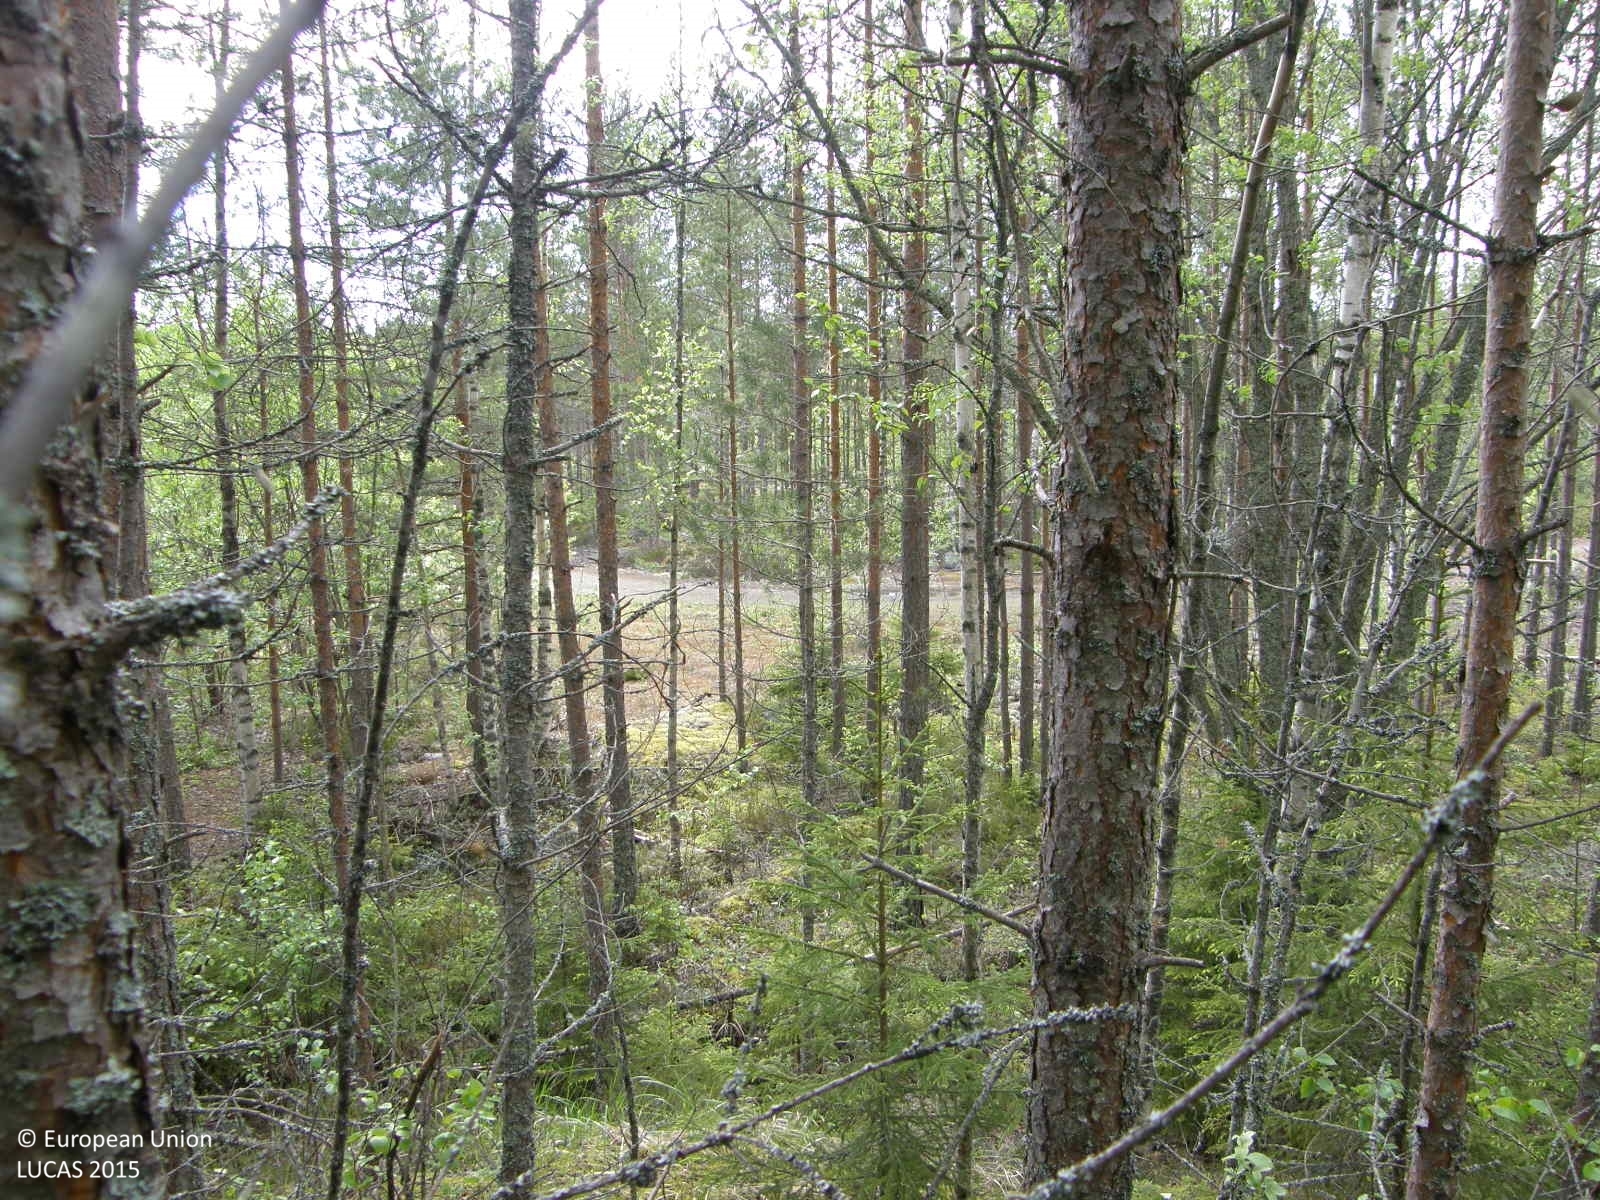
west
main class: Woodland
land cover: Pine dominated mixed woodland
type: boreal forest
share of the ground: > 75 %
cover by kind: coniferous forest trees 65 %, broadleaved forest trees 25 %, consolidated bare surface 5 %, unconsolidated bare surface 5 %
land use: Forestry
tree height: > 5 m
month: June
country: FI
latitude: 61.9391
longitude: 21.6542
